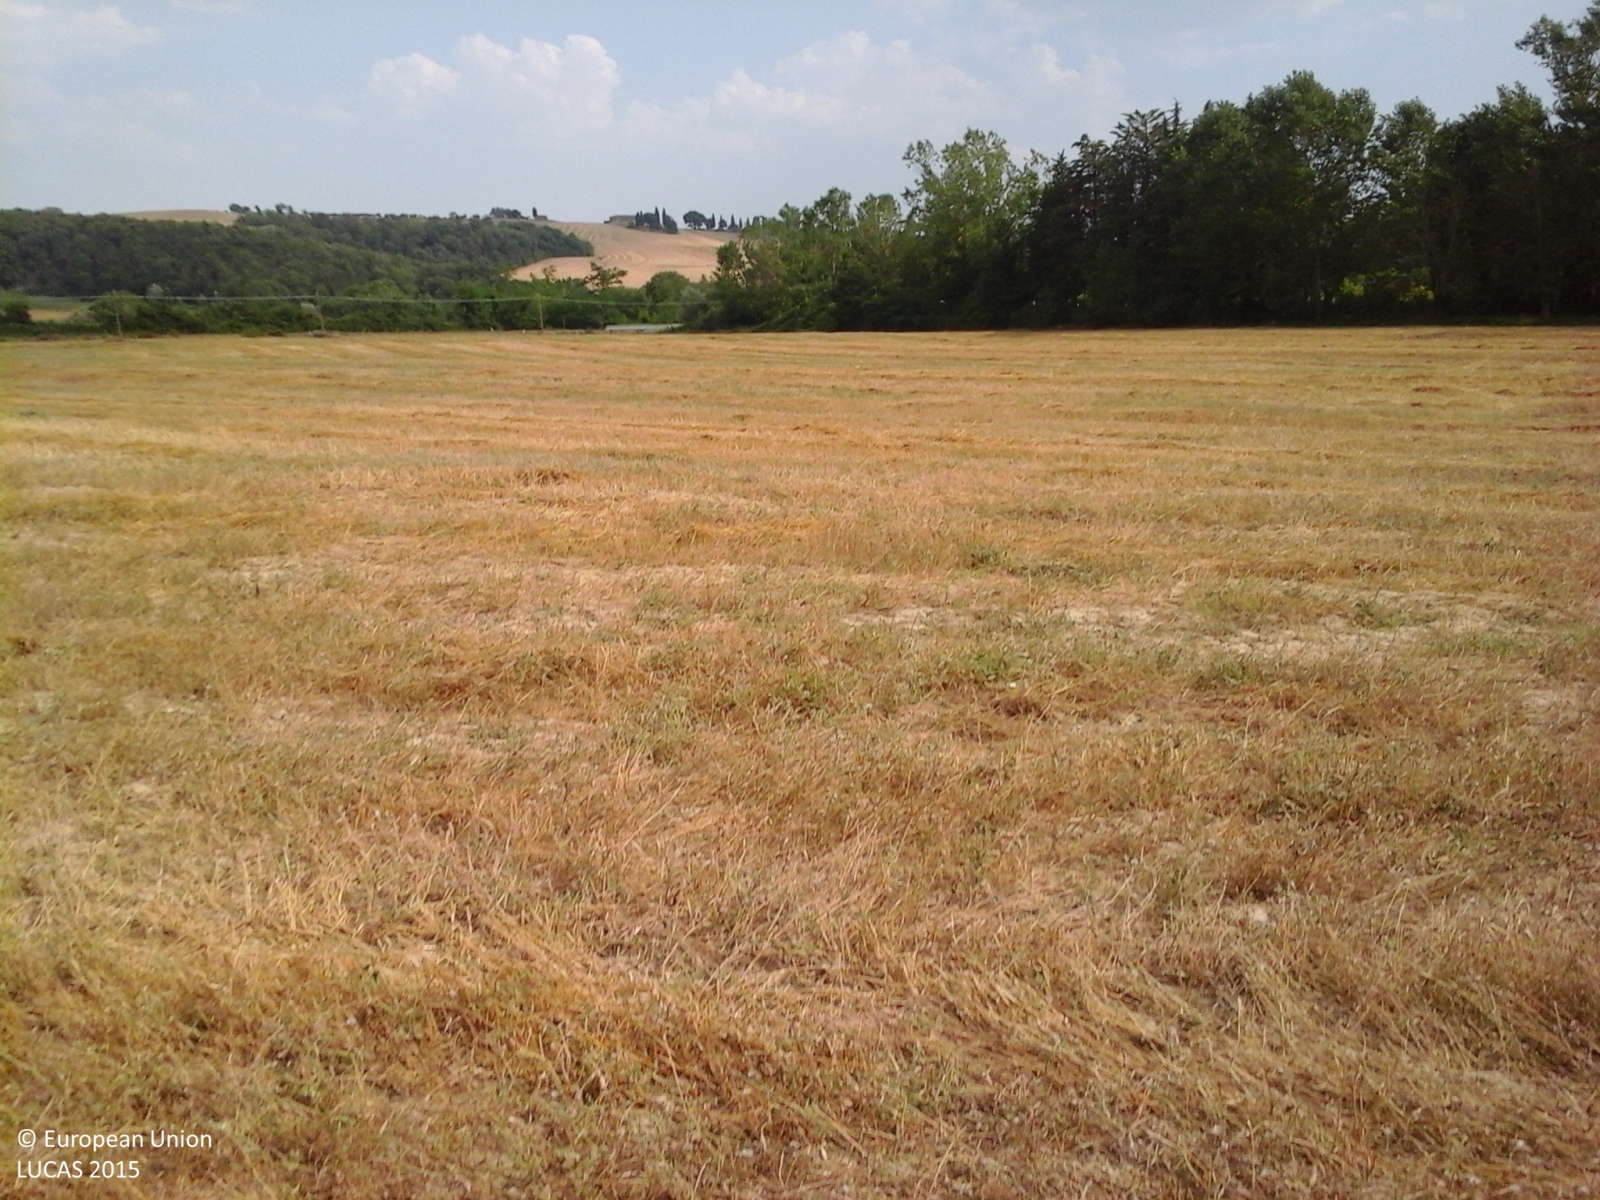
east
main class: Cropland
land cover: Mixed cereals for fodder
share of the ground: > 75 %
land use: Agriculture (excluding fallow land and kitchen gardens)
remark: Harvested field
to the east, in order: Mixed cereals for fodder; Durum wheat; Electric lines; Grass margins; Paved roads, cycling and walking lanes; Grass margins; Grassland without tree/shrub cover
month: July
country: IT
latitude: 43.1474
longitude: 11.5815
